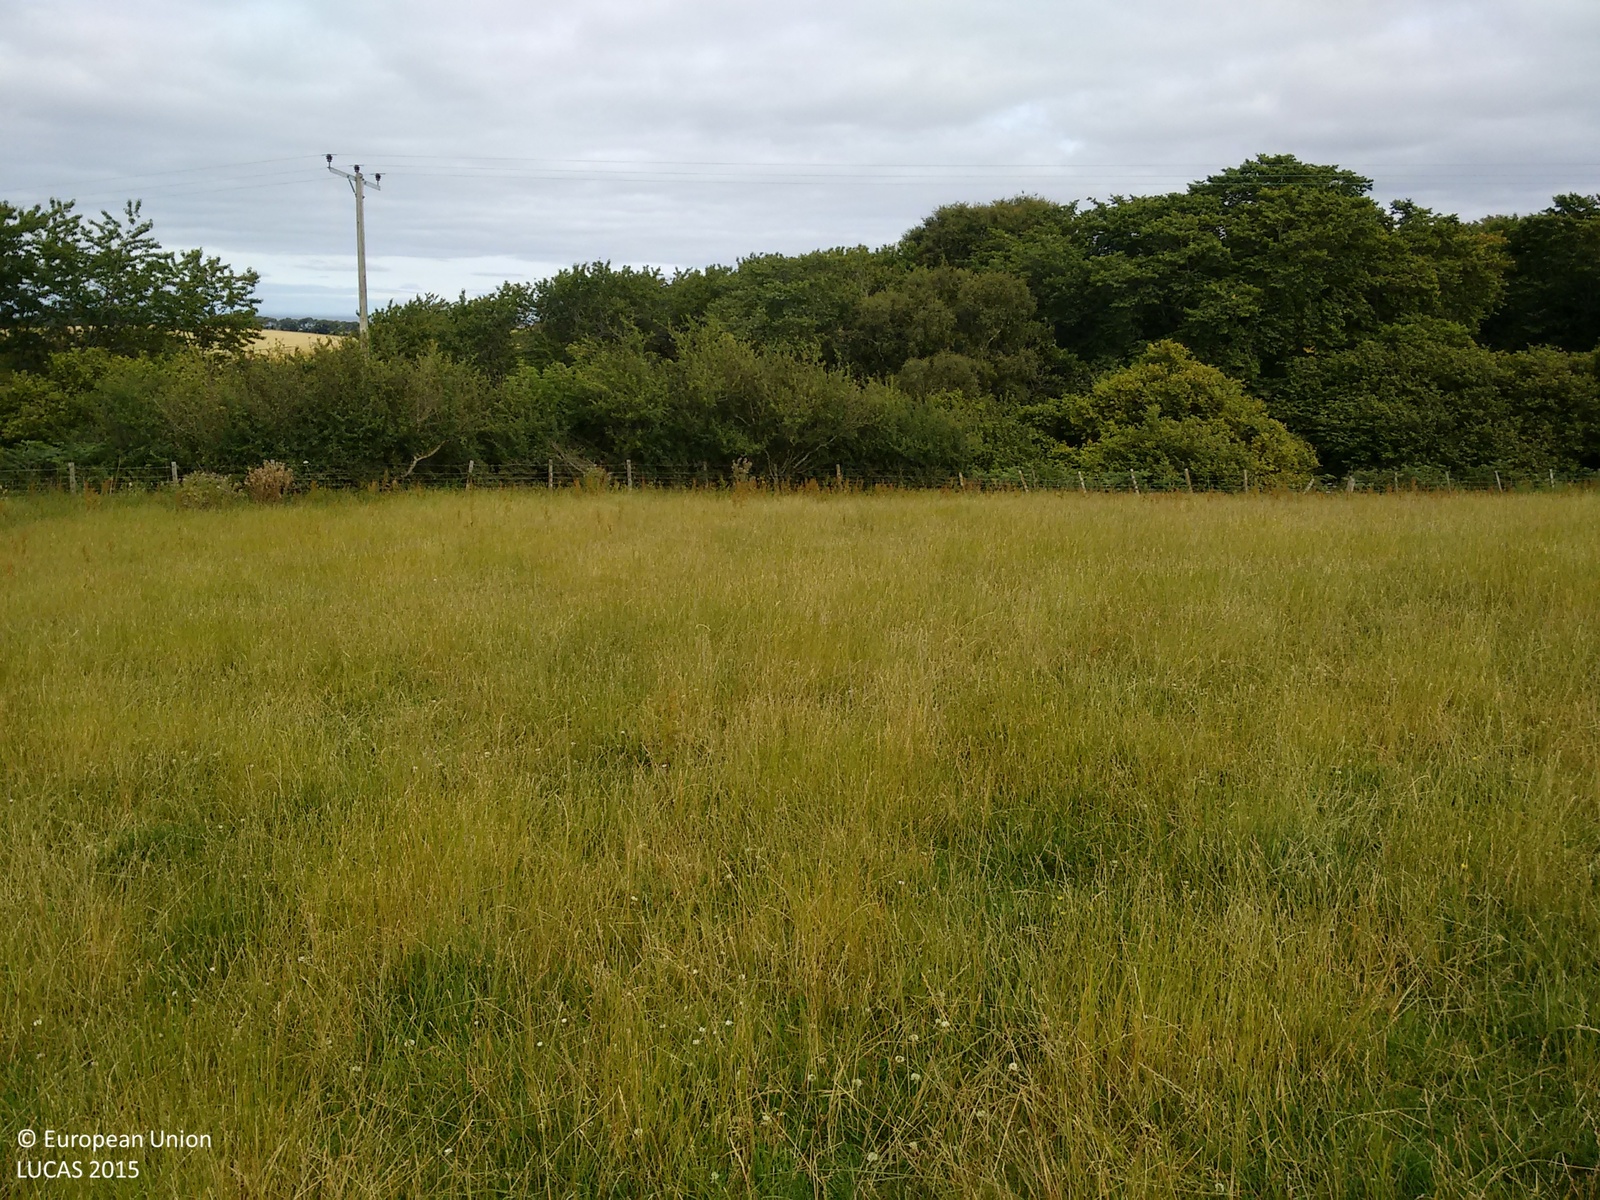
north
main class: Grassland
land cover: Grassland without tree/shrub cover
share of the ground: > 75 %
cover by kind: herbaceous plants 100 %
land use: Agriculture (excluding fallow land and kitchen gardens)
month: August
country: GB
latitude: 57.6208
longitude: -3.0026
